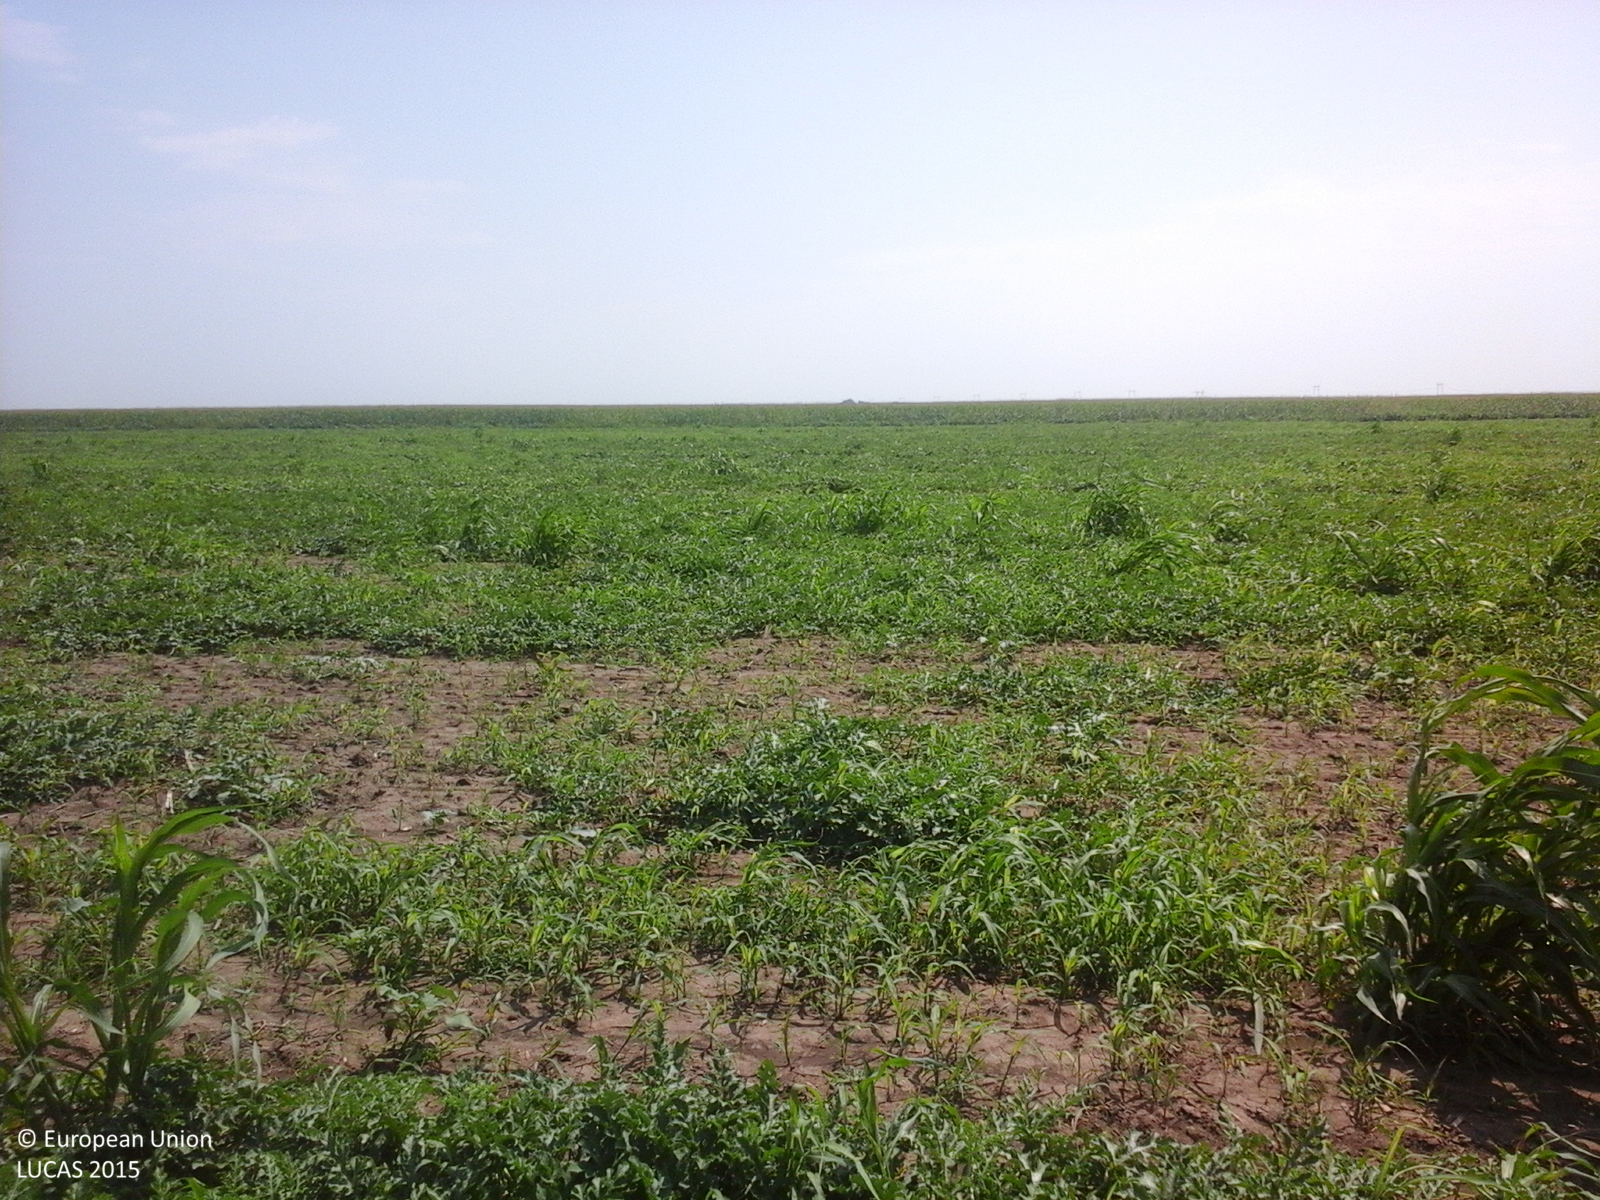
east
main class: Cropland
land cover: Other fresh vegetables
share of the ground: > 75 %
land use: Agriculture (excluding fallow land and kitchen gardens)
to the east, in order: Other fresh vegetables; Maize
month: July
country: RO
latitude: 44.6412
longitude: 27.1417
